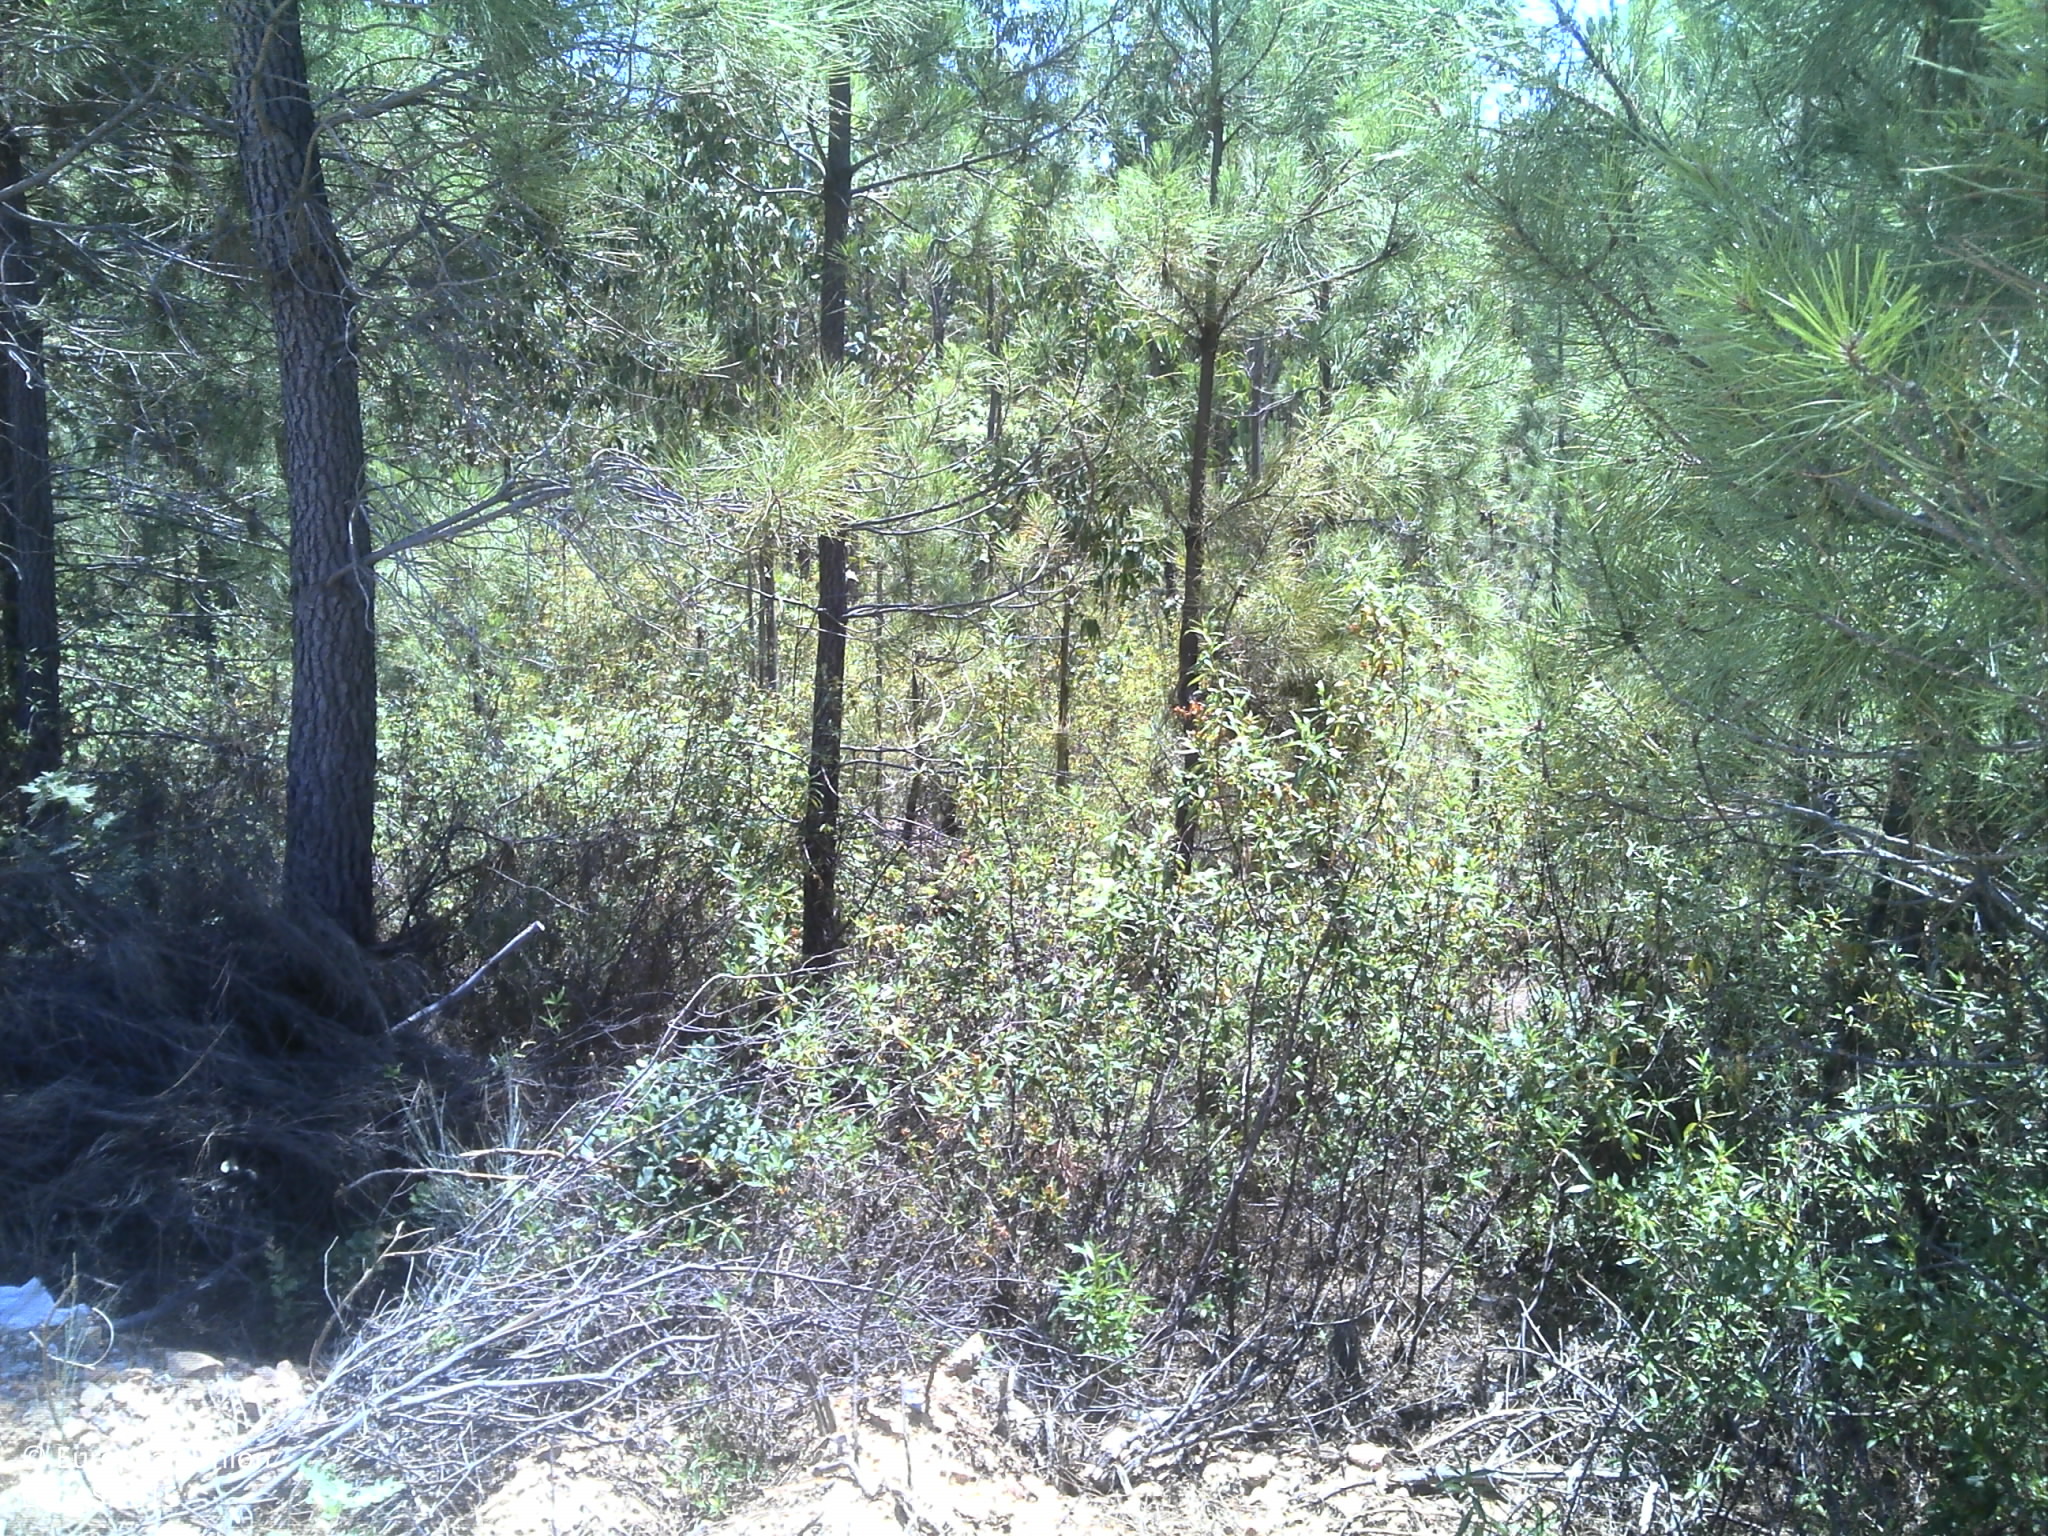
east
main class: Woodland
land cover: Pine dominated coniferous woodland
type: coniferous forest of the mediterranean region
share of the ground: 50 - 75 %
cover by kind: coniferous forest trees 70 %, shrubs 10 %, unconsolidated bare surface 10 %, herbaceous plants 5 %
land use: Forestry
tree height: > 5 m
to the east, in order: Pine dominated coniferous woodland; Dry stone walls; Broadleaved woodland; Tracks; Other bare soil; Pine dominated coniferous woodland
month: June
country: PT
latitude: 40.0836
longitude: -7.0872
